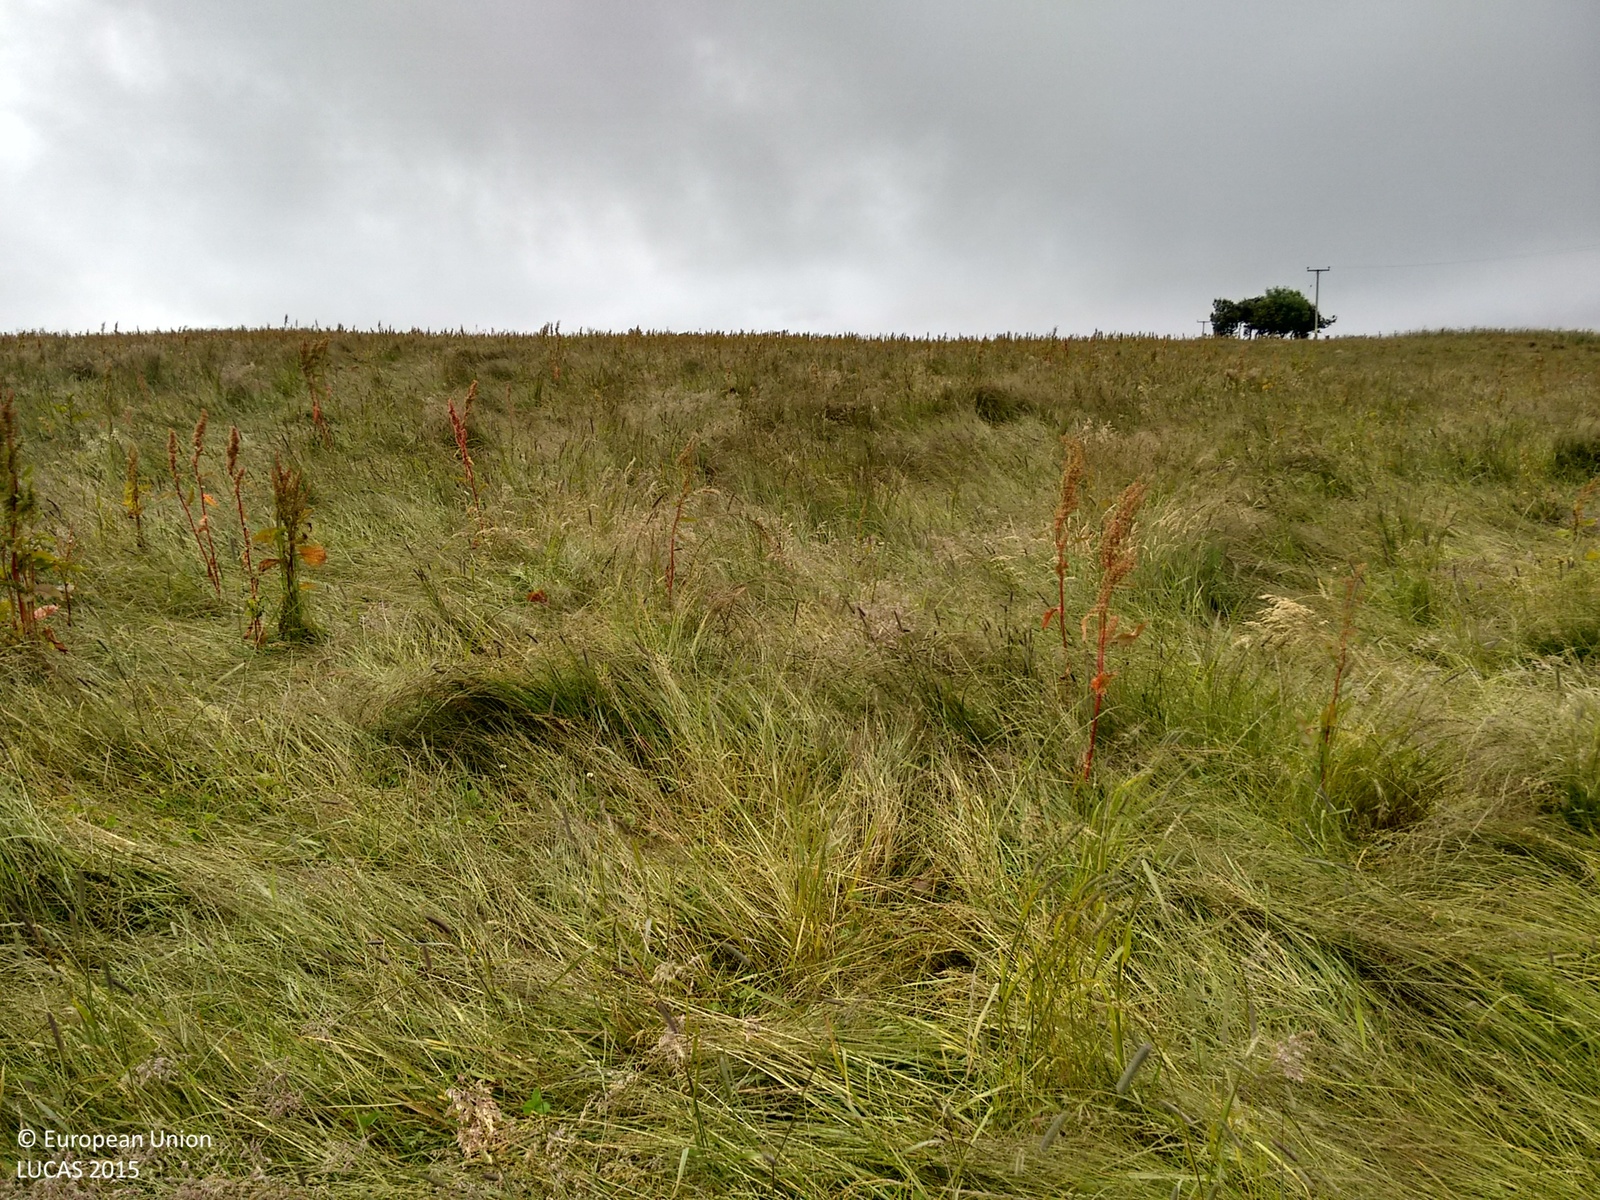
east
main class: Grassland
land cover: Grassland without tree/shrub cover
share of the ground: > 75 %
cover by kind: herbaceous plants 100 %
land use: Agriculture (excluding fallow land and kitchen gardens)
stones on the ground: 25 - 50 %
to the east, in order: Grassland without tree/shrub cover; Fences; Grass margins; Fences; Lines of trees; Grassland without tree/shrub cover; Fences; Grassland without tree/shrub cover; Electric lines; Fences; Grass margins; Fences; Grassland without tree/shrub cover
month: July
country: GB
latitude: 57.6313
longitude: -2.3252
